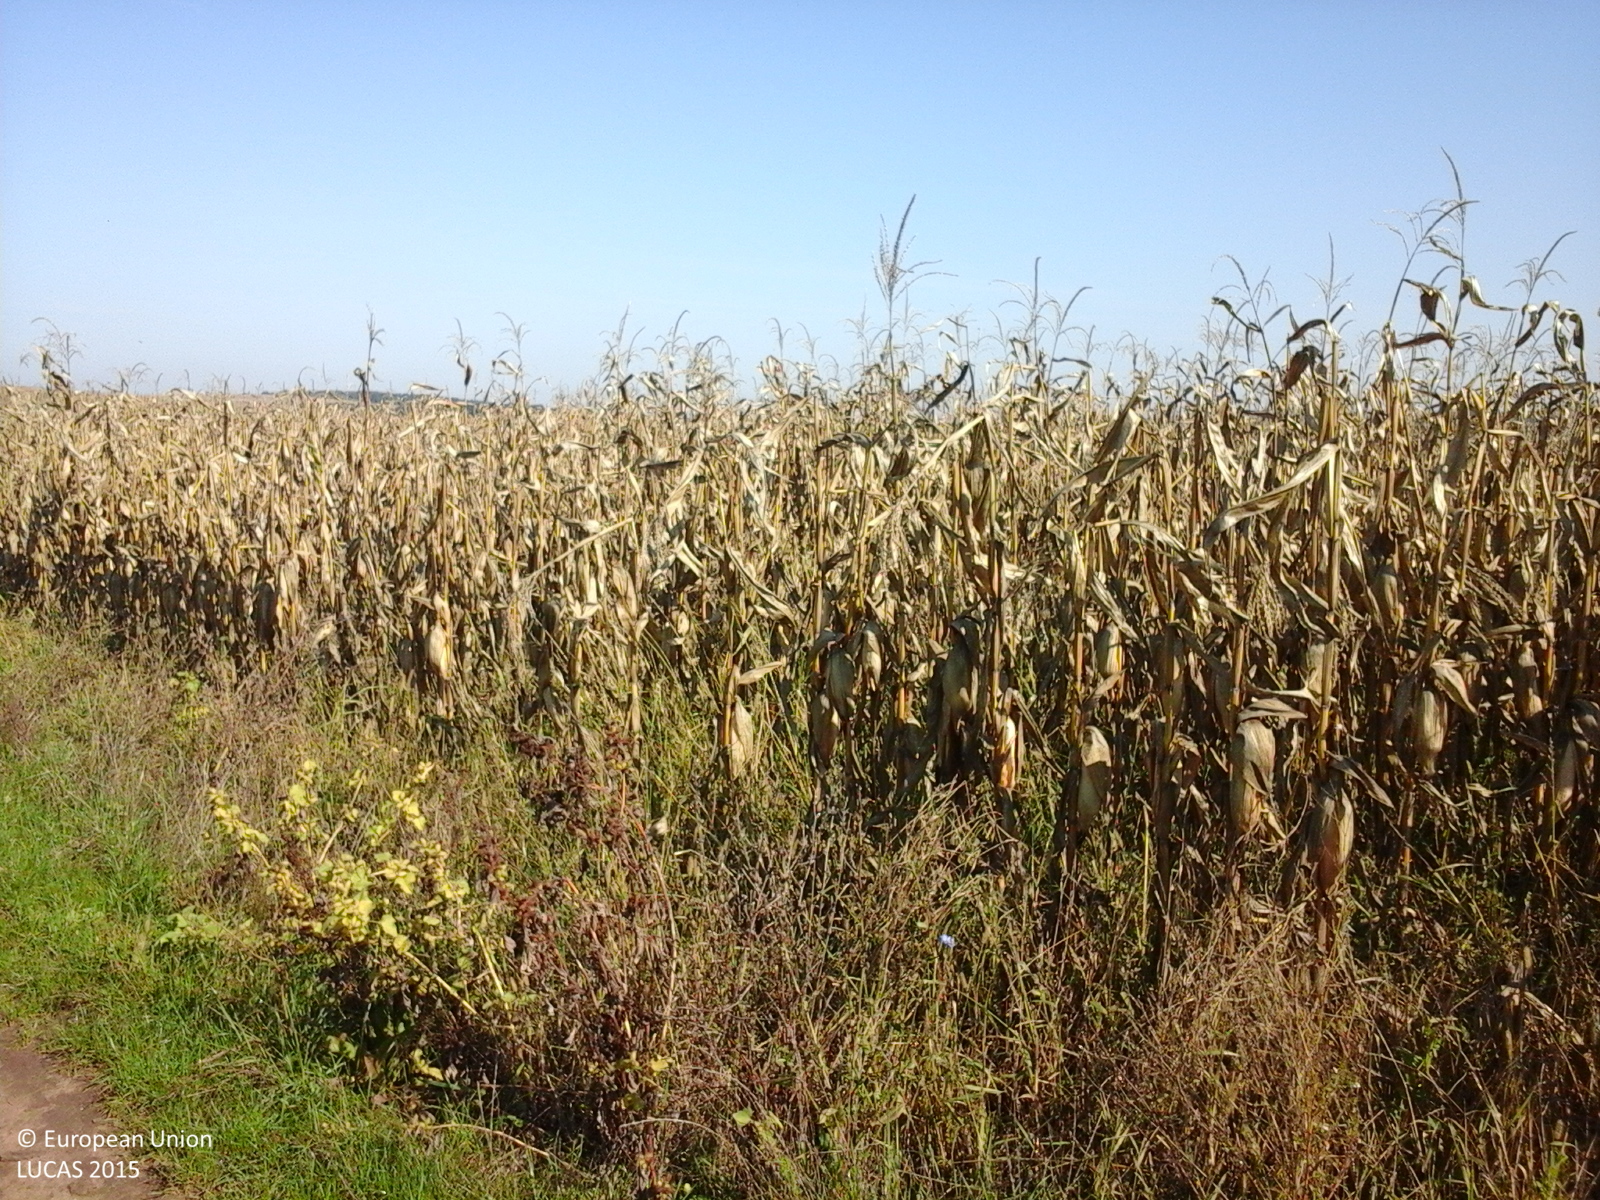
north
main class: Cropland
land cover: Maize
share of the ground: > 75 %
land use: Agriculture (excluding fallow land and kitchen gardens)
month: October
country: RO
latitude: 46.0993
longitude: 23.8741
